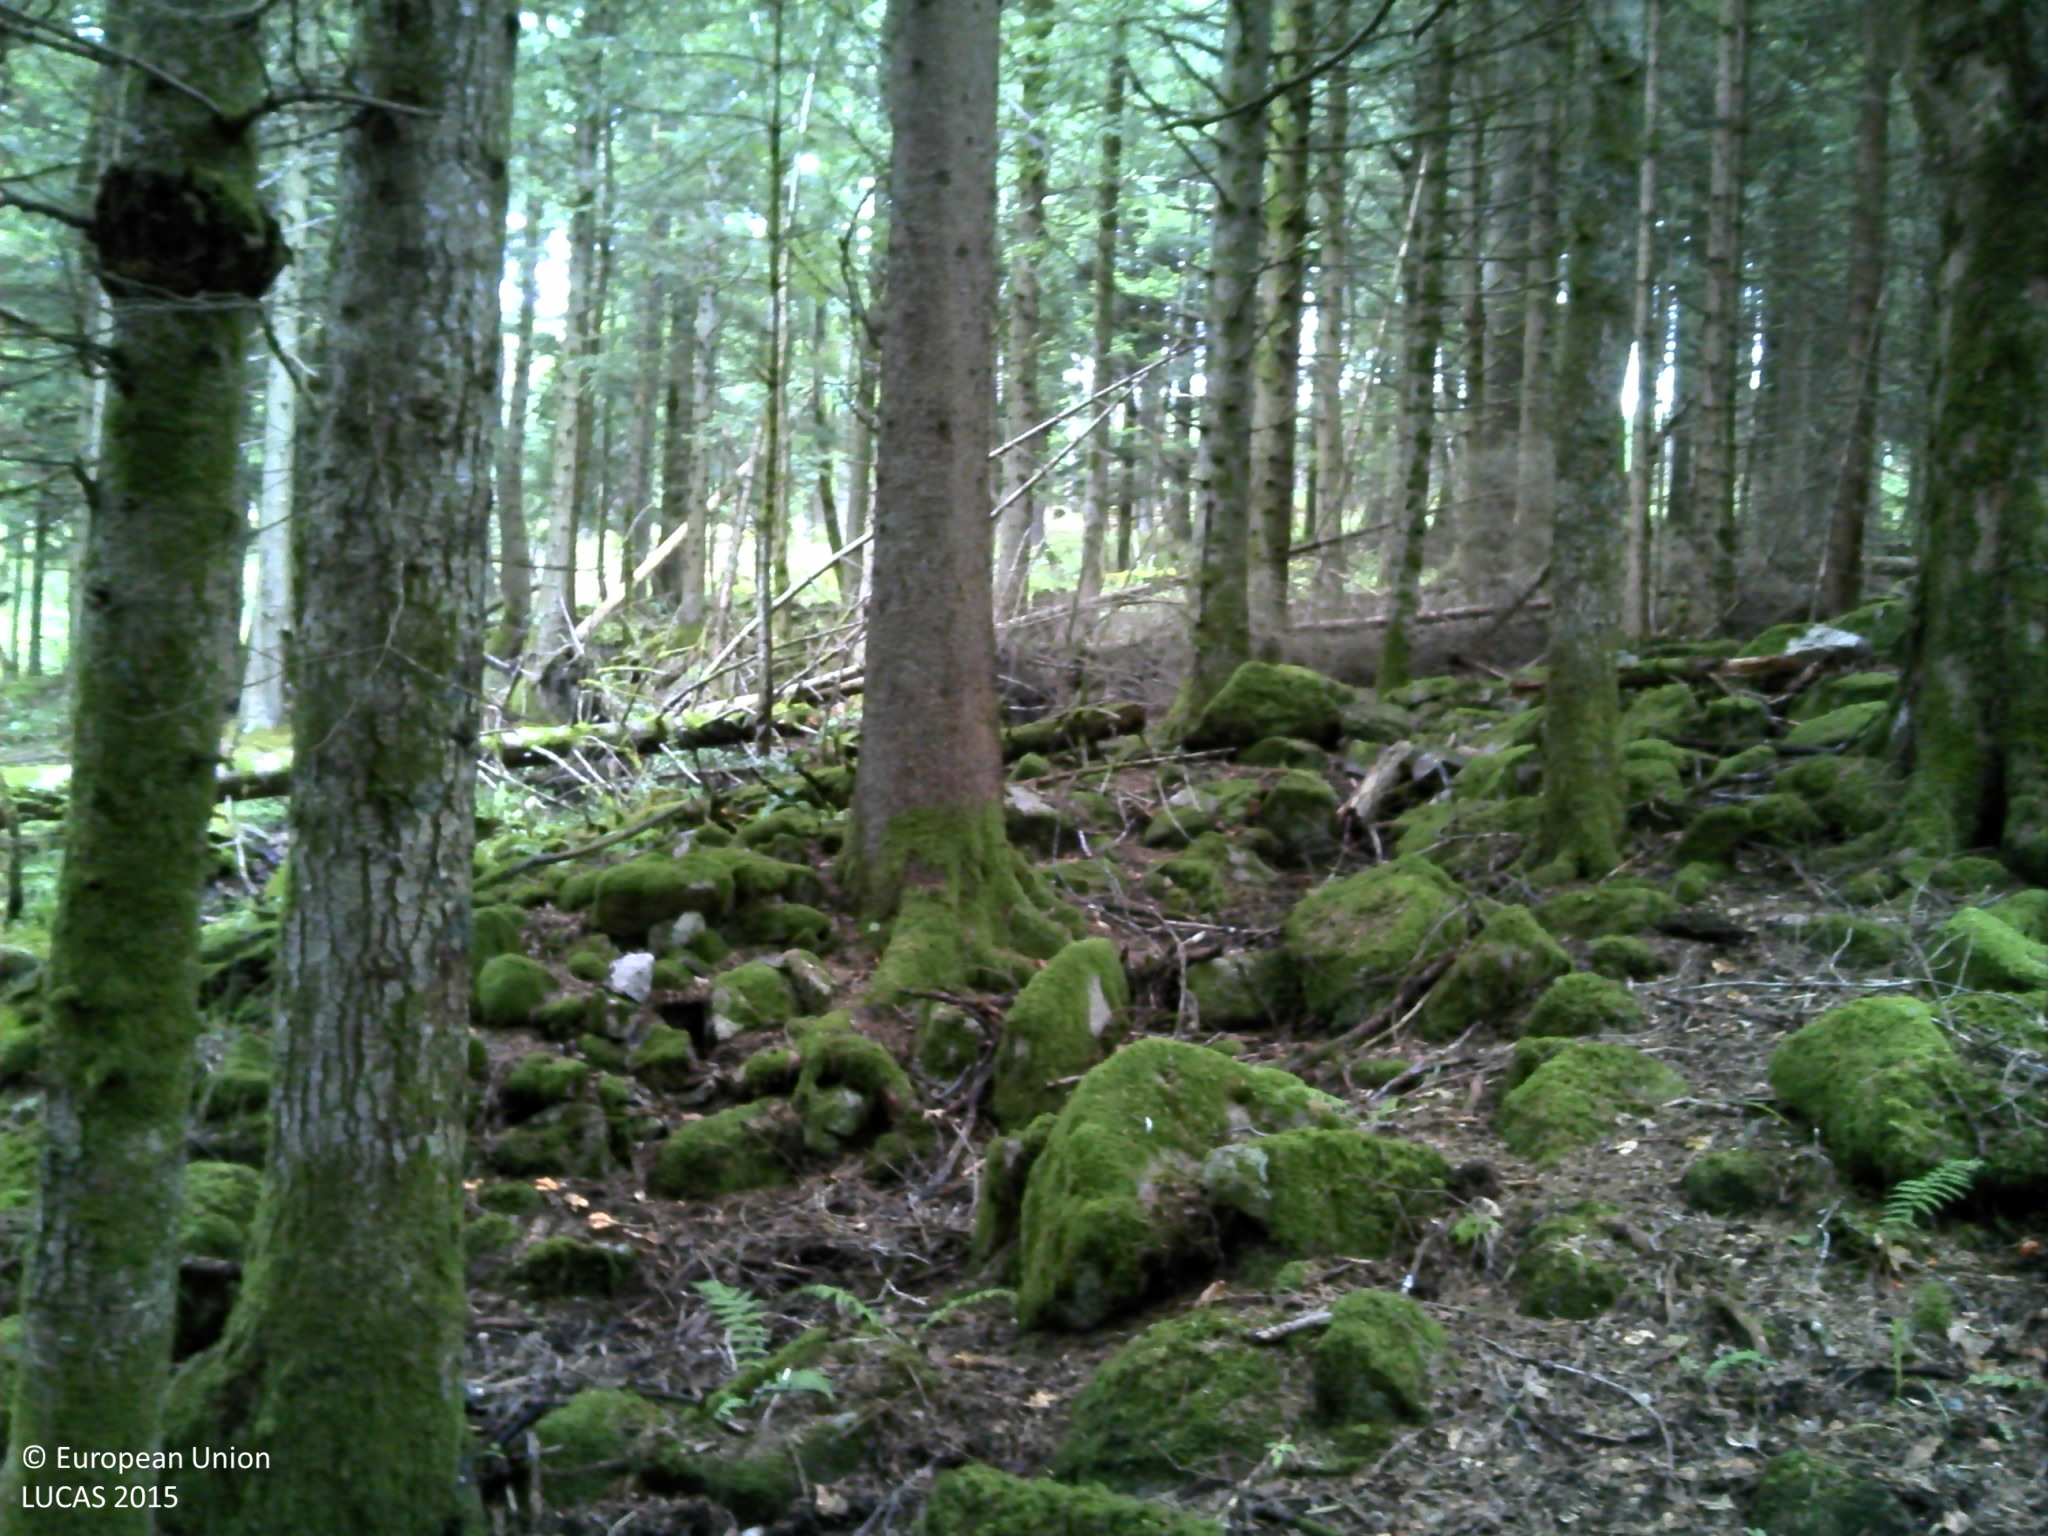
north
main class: Woodland
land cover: Spruce dominated mixed woodland
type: hemiboreal forest and nemoral coniferous forest and mixed broadleaved-coniferous forest
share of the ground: > 75 %
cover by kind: coniferous forest trees 50 %, broadleaved forest trees 30 %, consolidated bare surface 10 %, herbaceous plants 5 %, lichens and mosses 5 %
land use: Forestry
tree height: > 5 m
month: September
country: FR
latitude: 48.4242
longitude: 7.2846
